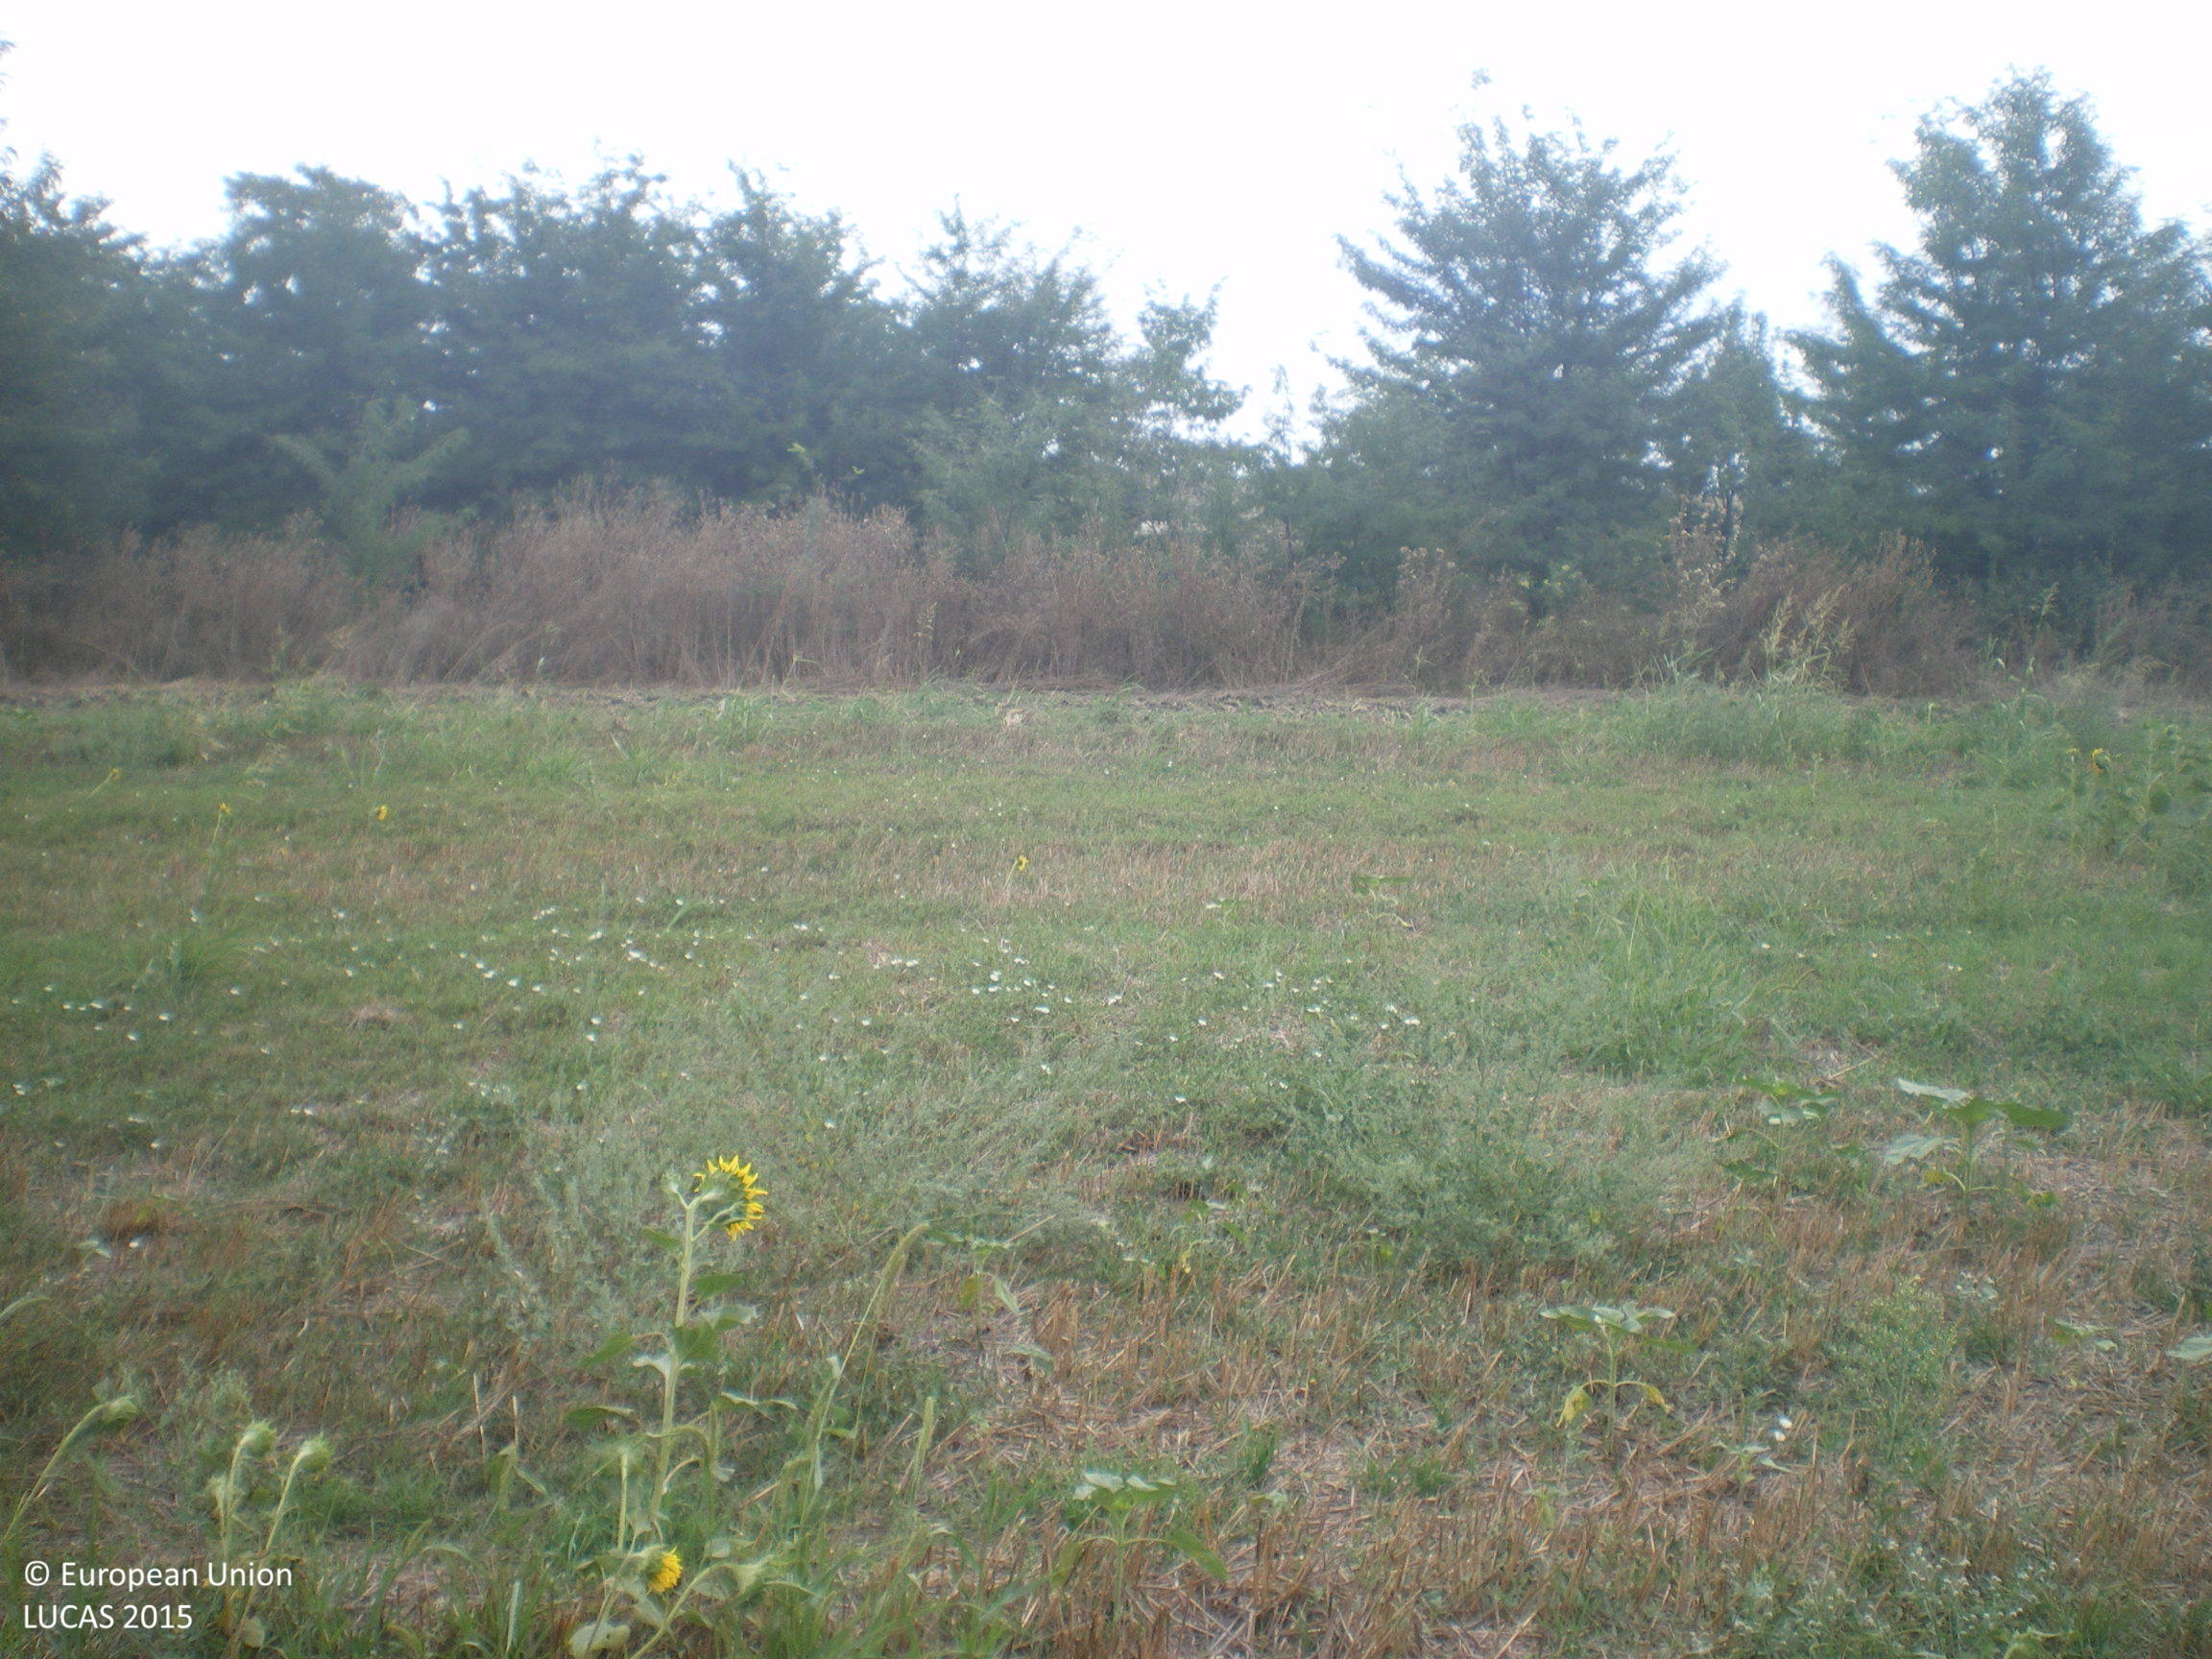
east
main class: Cropland
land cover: Common wheat
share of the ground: < 10 %
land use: Agriculture (excluding fallow land and kitchen gardens)
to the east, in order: Common wheat; Lines of trees; Grass margins; Paved roads, cycling and walking lanes; Grass margins; Ditches and canals; Lines of trees; Grassland without tree/shrub cover; Spontaneously vegetated surfaces
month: September
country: BG
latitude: 42.2456
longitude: 25.9408
